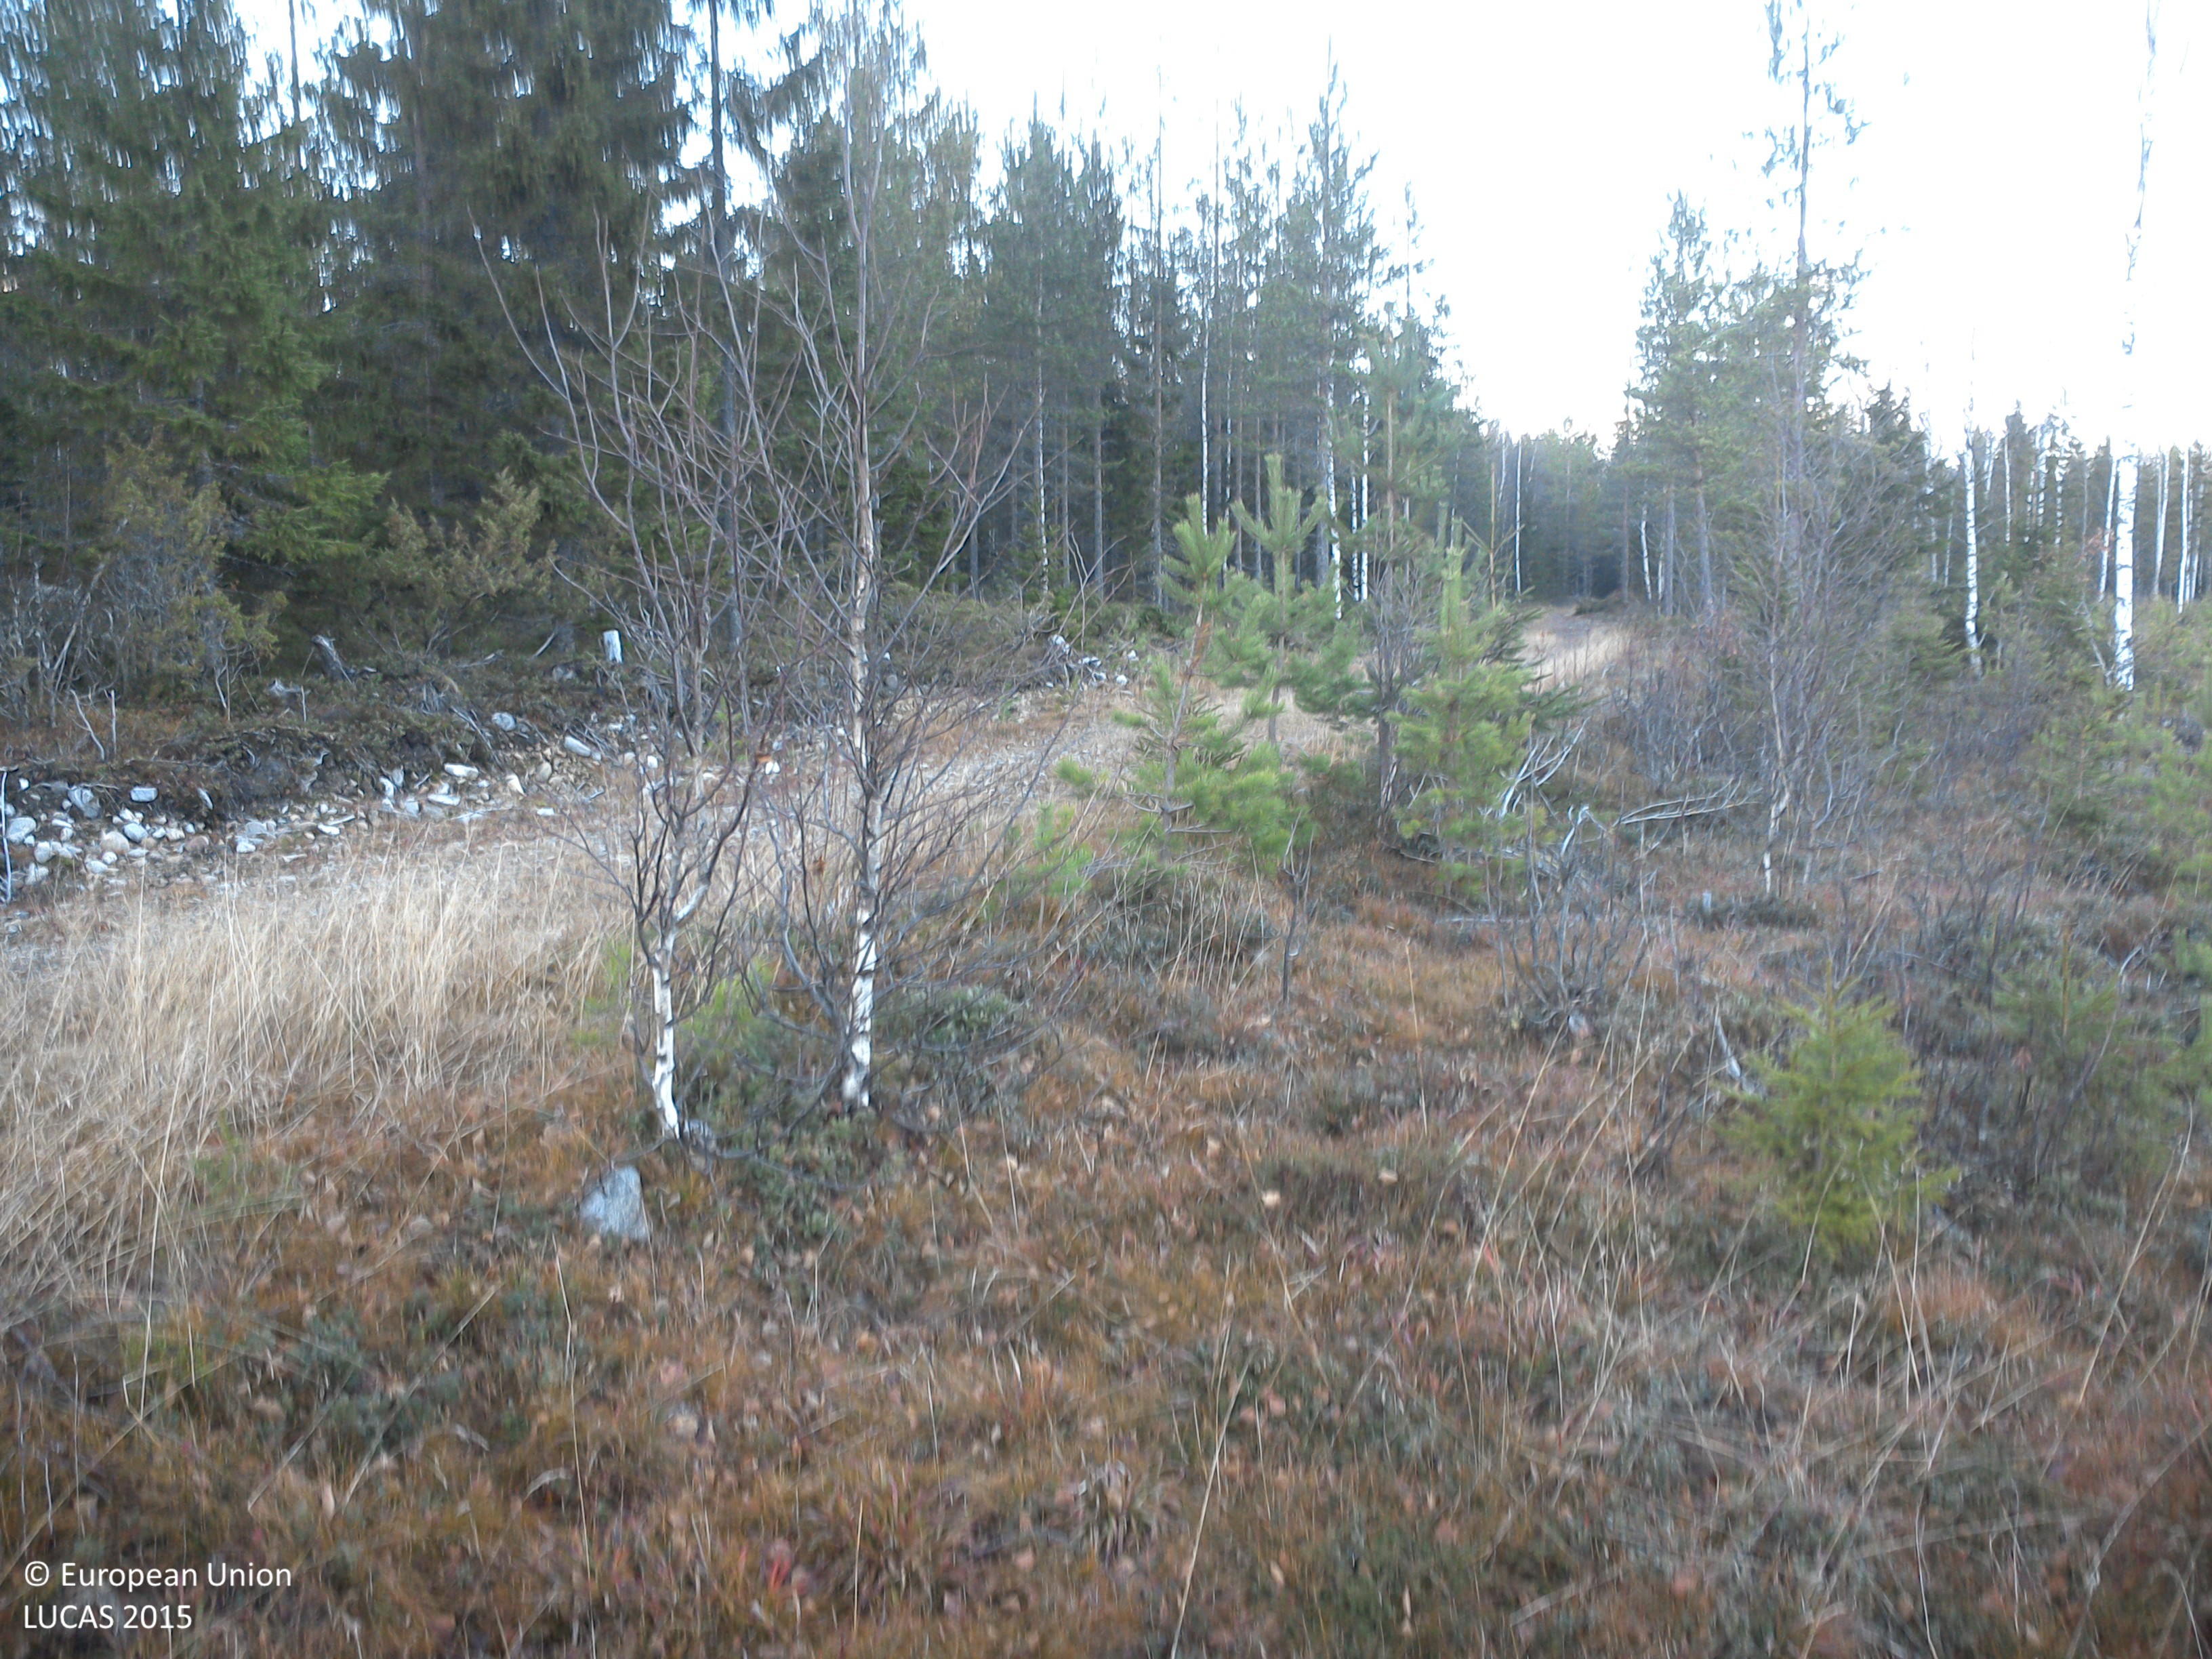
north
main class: Woodland
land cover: Pine dominated coniferous woodland
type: boreal forest
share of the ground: 25 - 50 %
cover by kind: shrubs 40 %, herbaceous plants 30 %, coniferous forest trees 25 %, broadleaved forest trees 5 %
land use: Forestry
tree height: < 5 m
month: November
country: SE
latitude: 63.7581
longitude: 19.9333
